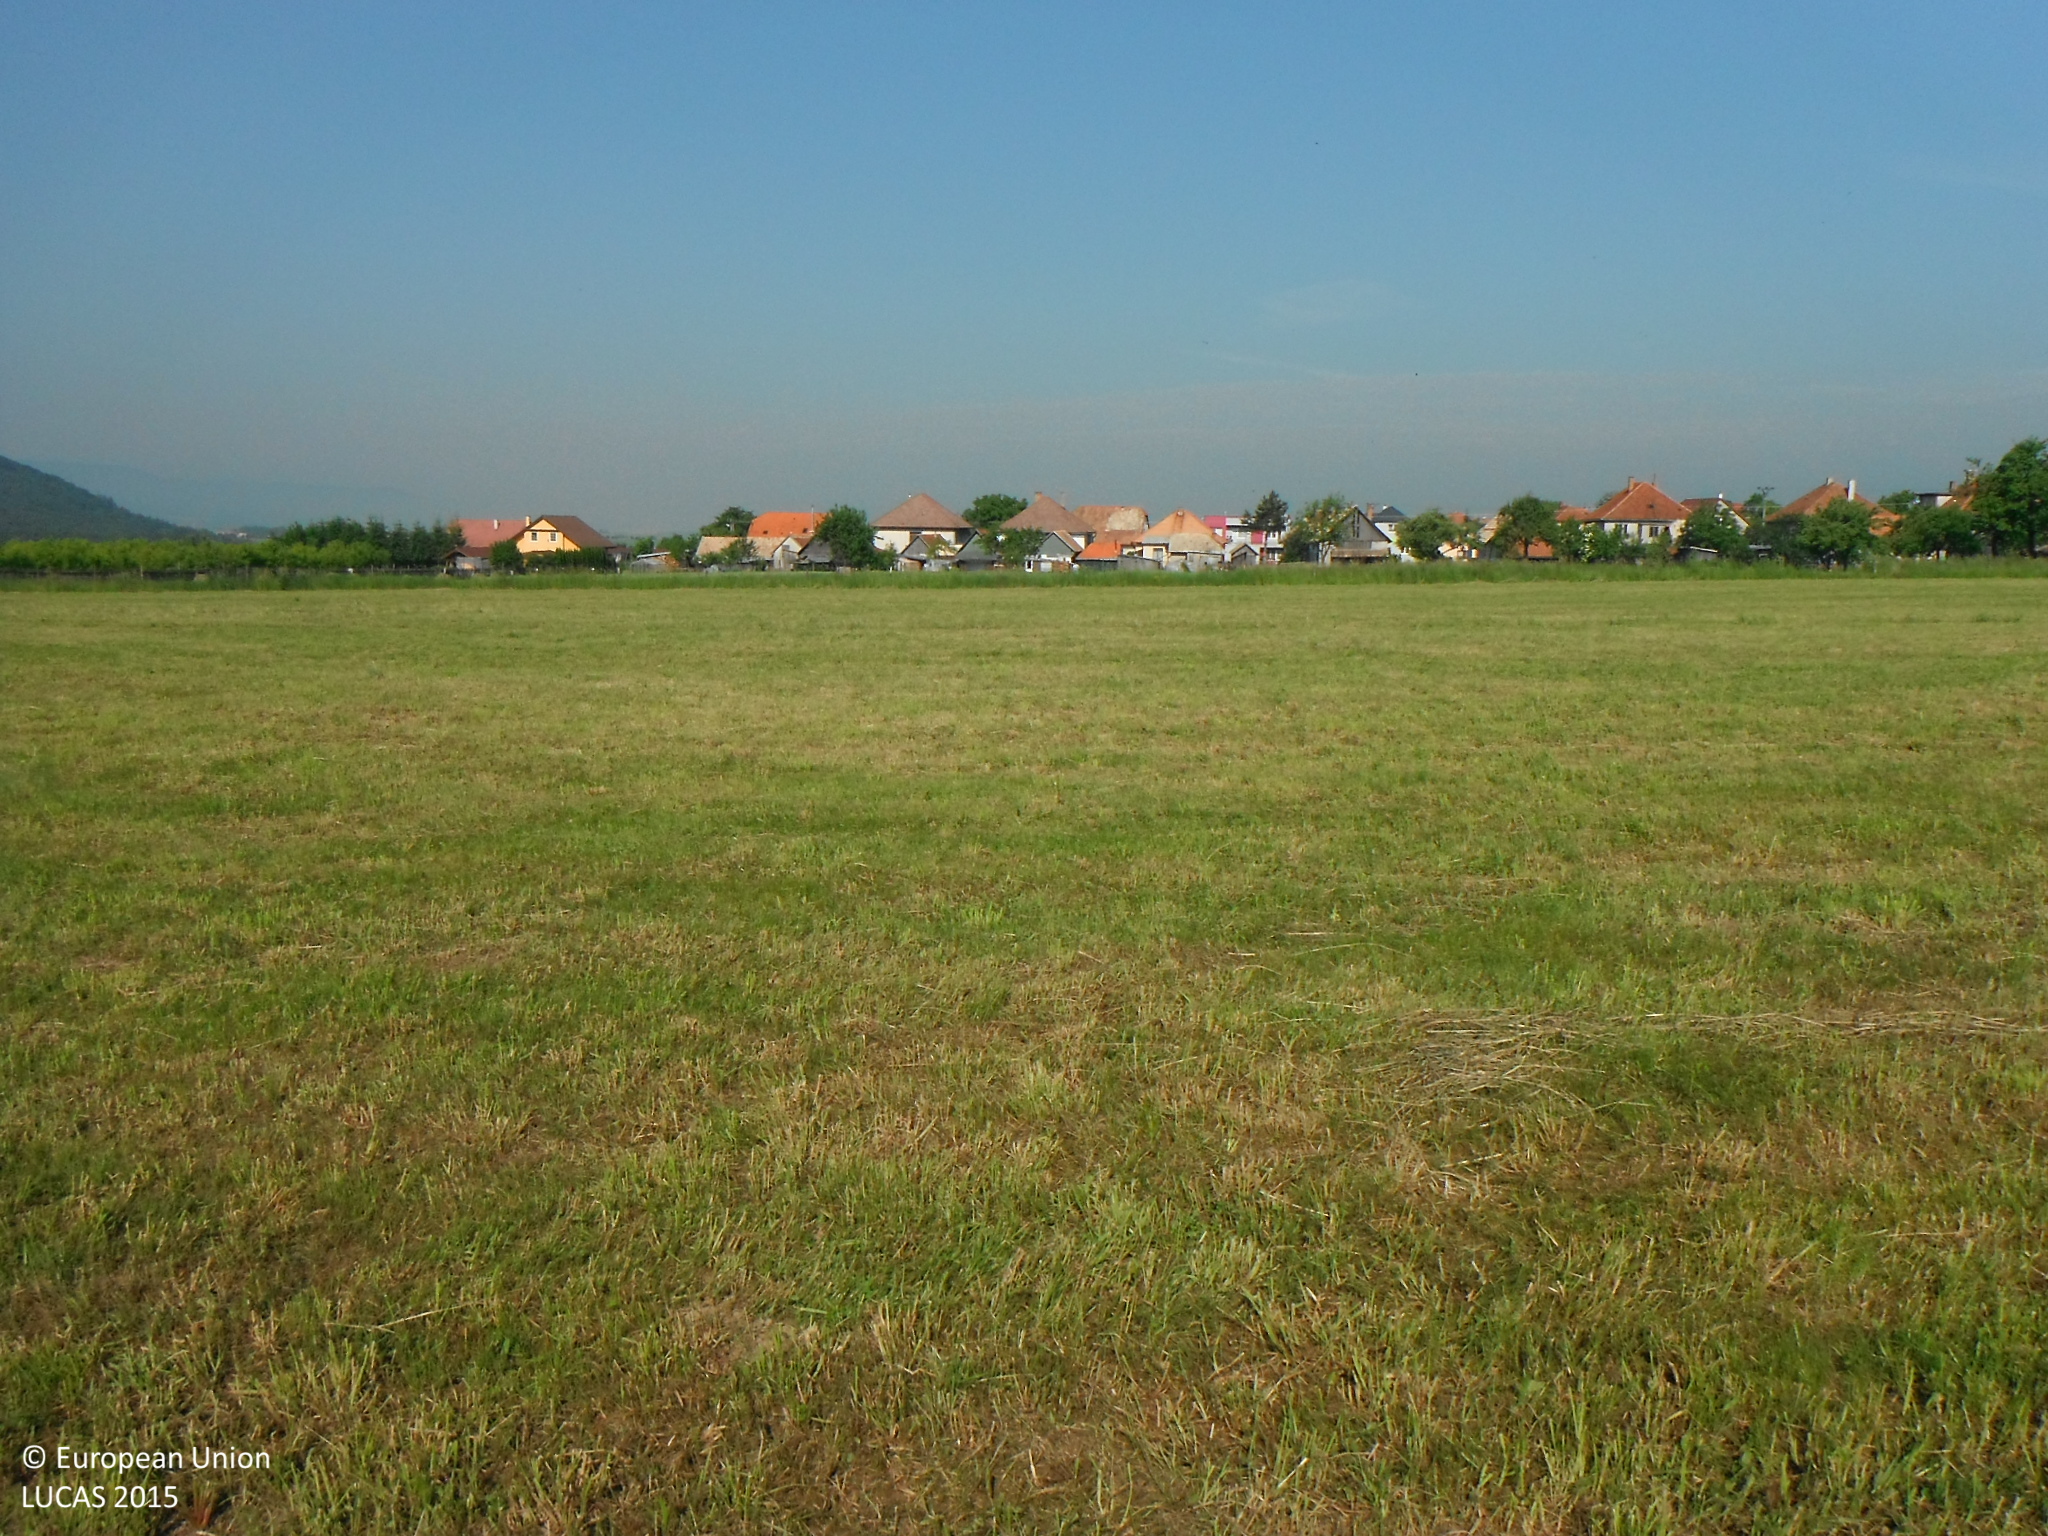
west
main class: Grassland
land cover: Grassland without tree/shrub cover
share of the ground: > 75 %
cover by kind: herbaceous plants 100 %
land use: Agriculture (excluding fallow land and kitchen gardens)
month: June
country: SK
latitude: 48.5849
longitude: 19.3642
